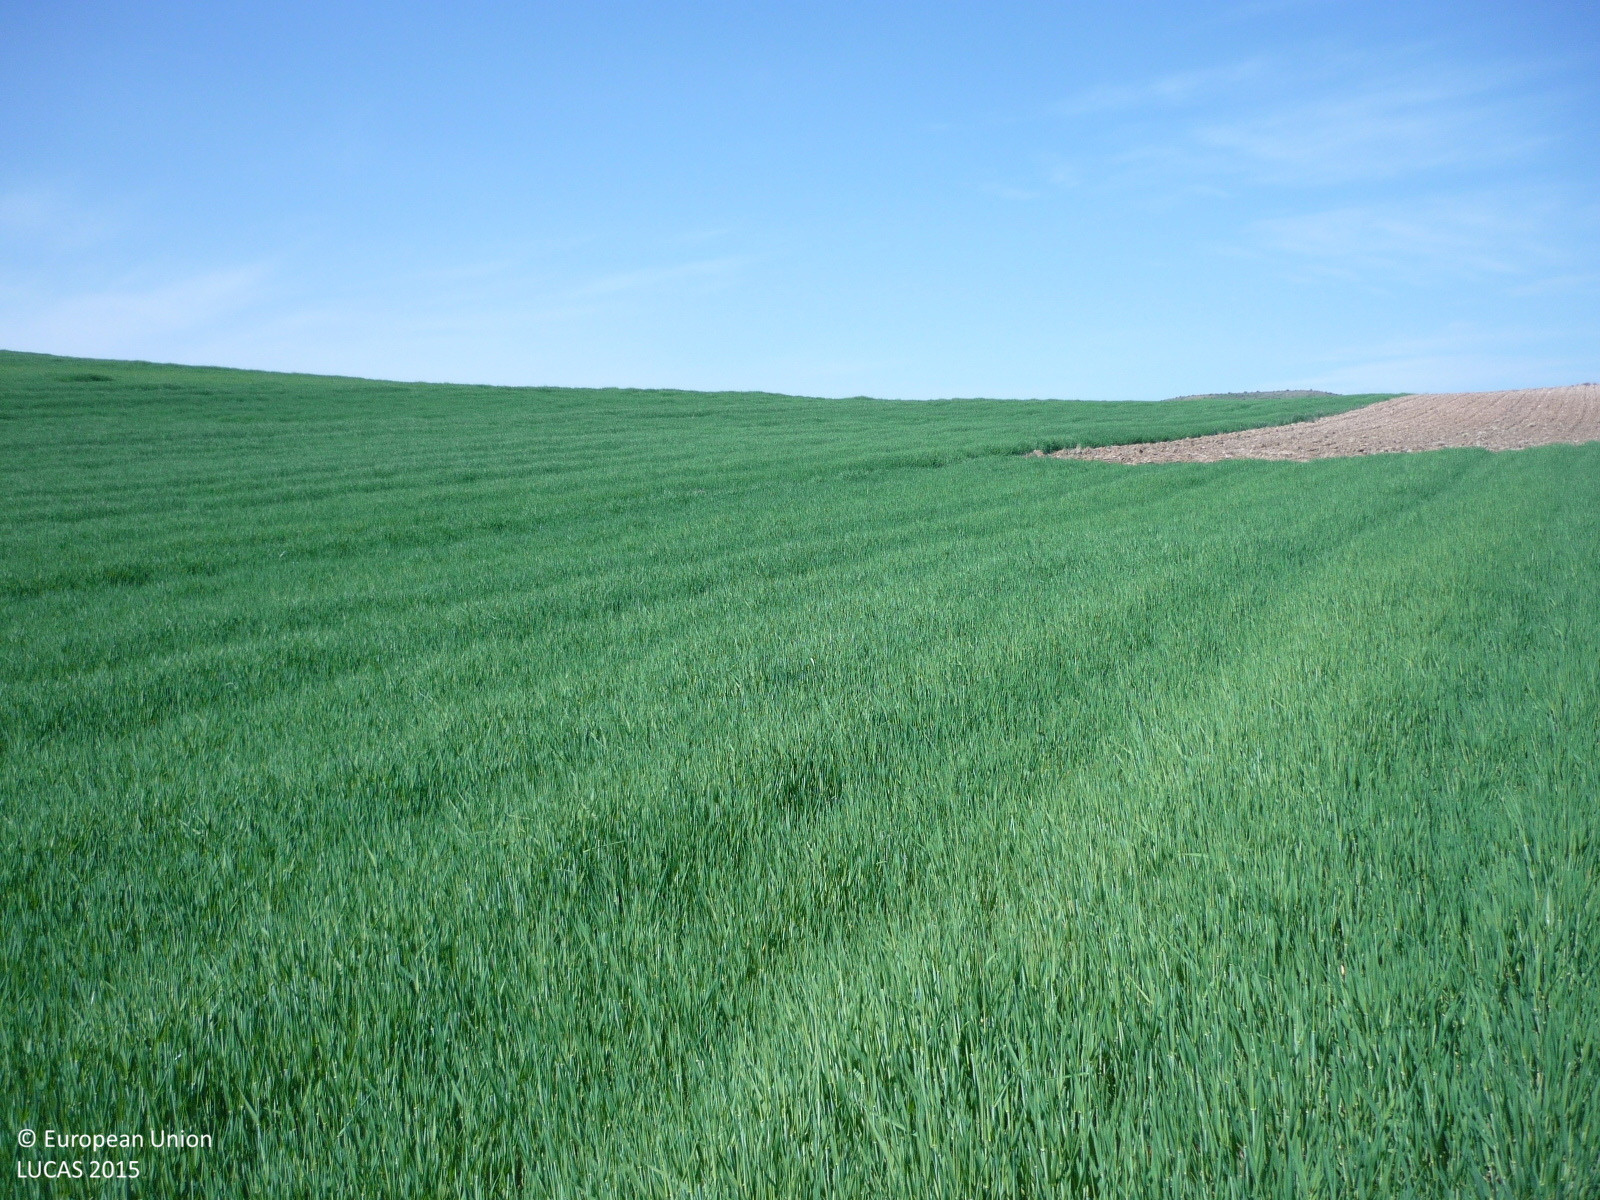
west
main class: Cropland
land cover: Barley
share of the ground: > 75 %
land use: Agriculture (excluding fallow land and kitchen gardens)
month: April
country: ES
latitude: 40.6128
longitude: -3.3562
